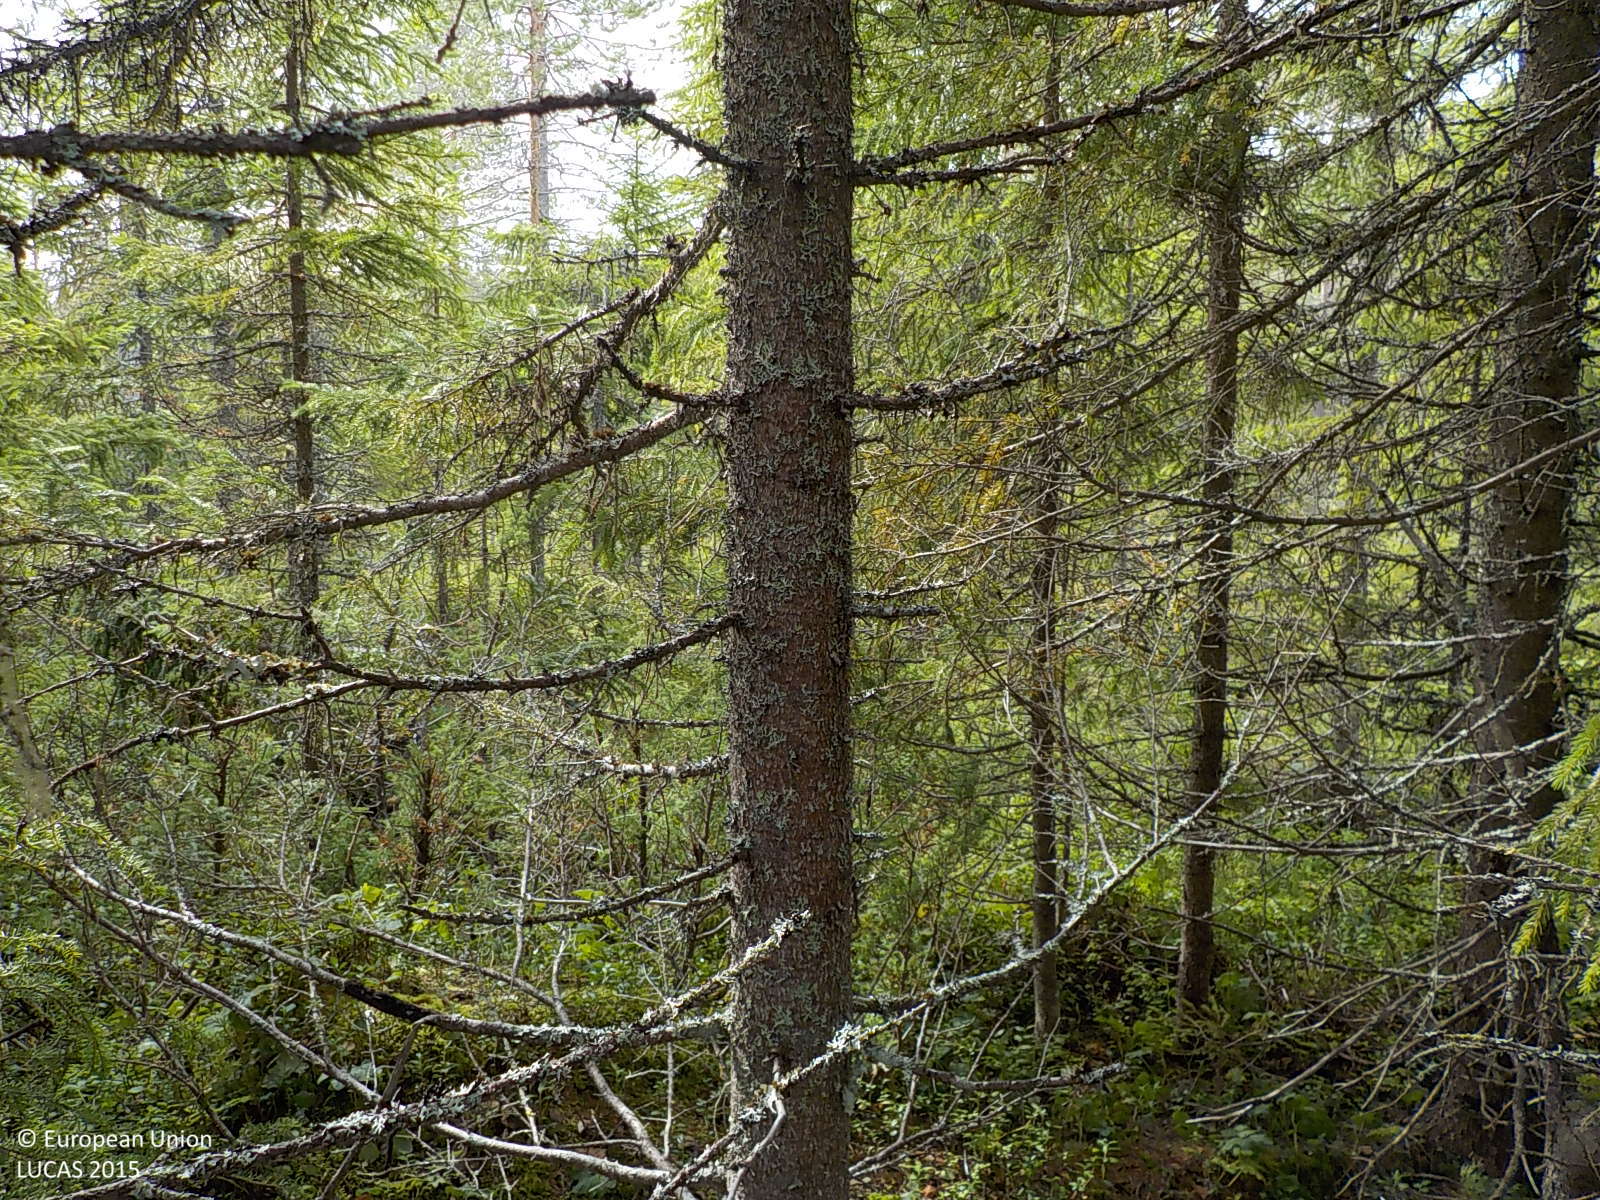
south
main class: Woodland
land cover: Spruce dominated coniferous woodland
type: boreal forest
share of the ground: > 75 %
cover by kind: coniferous forest trees 95 %, shrubs 5 %
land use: Forestry
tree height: > 5 m
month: September
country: SE
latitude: 63.3000
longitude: 17.7755
